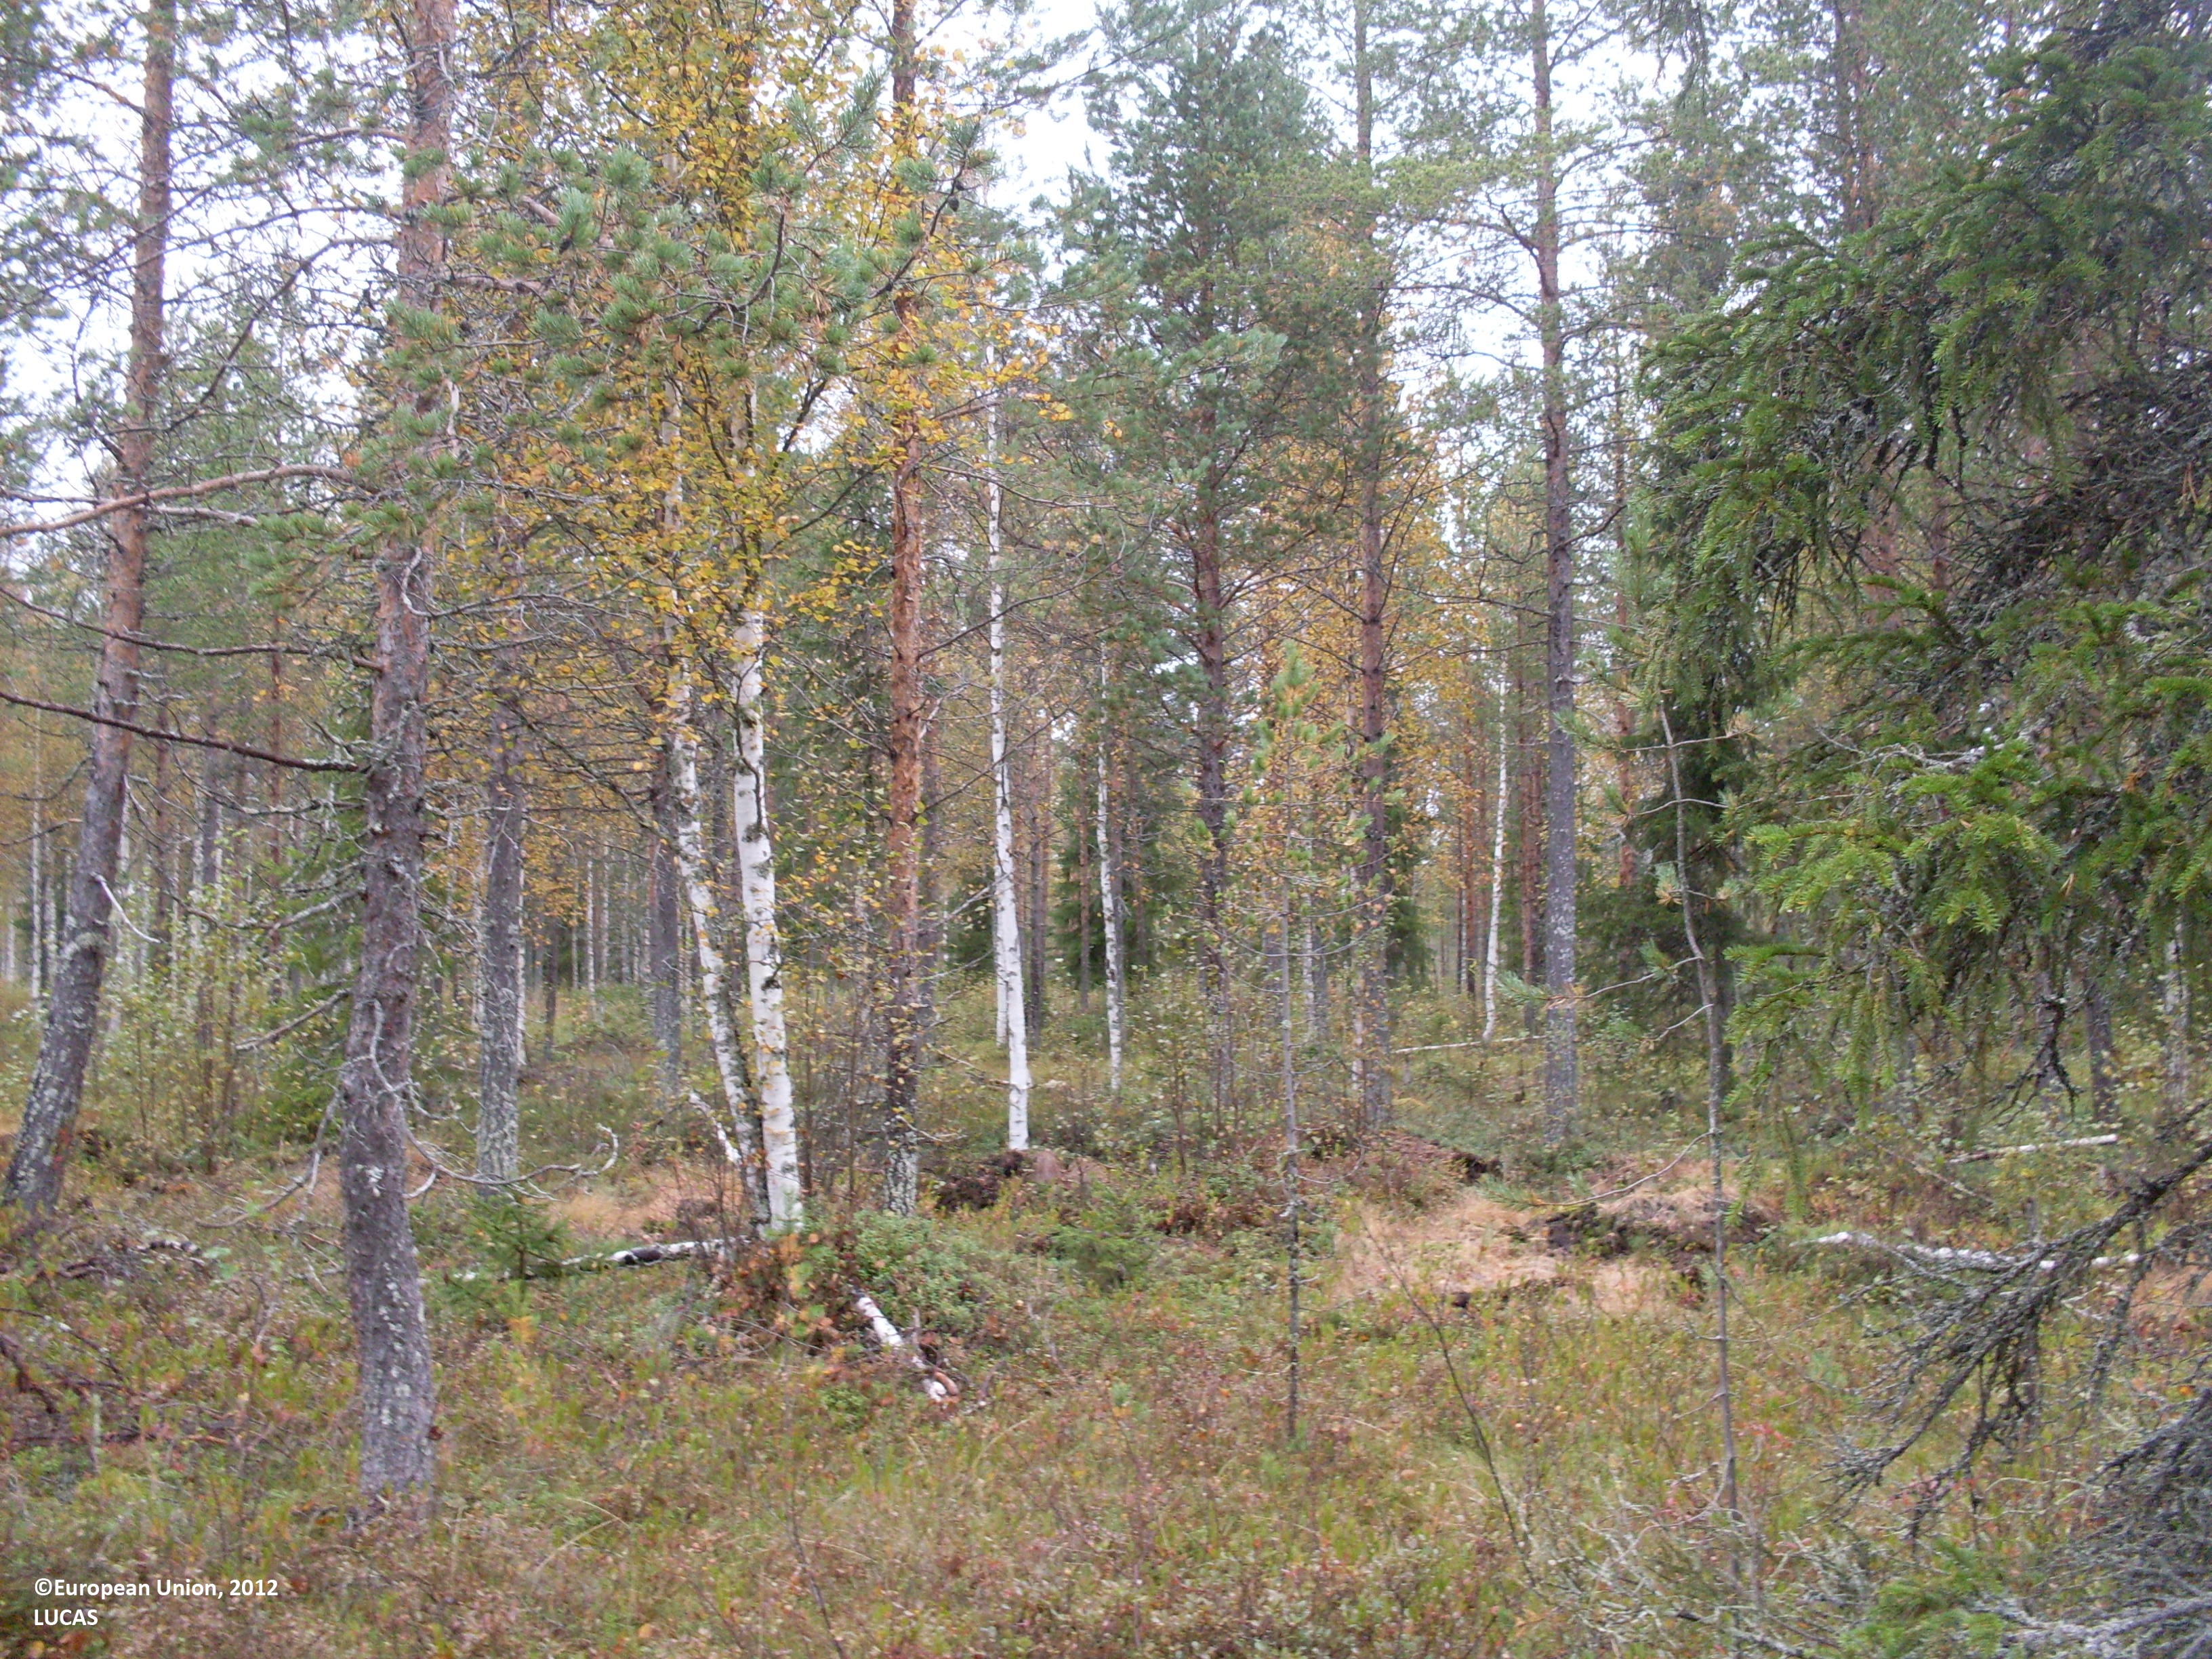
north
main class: Woodland
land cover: Other coniferous woodland
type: boreal forest
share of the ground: 50 - 75 %
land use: Forestry
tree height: > 5 m
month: September
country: FI
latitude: 64.0836
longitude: 30.2448
